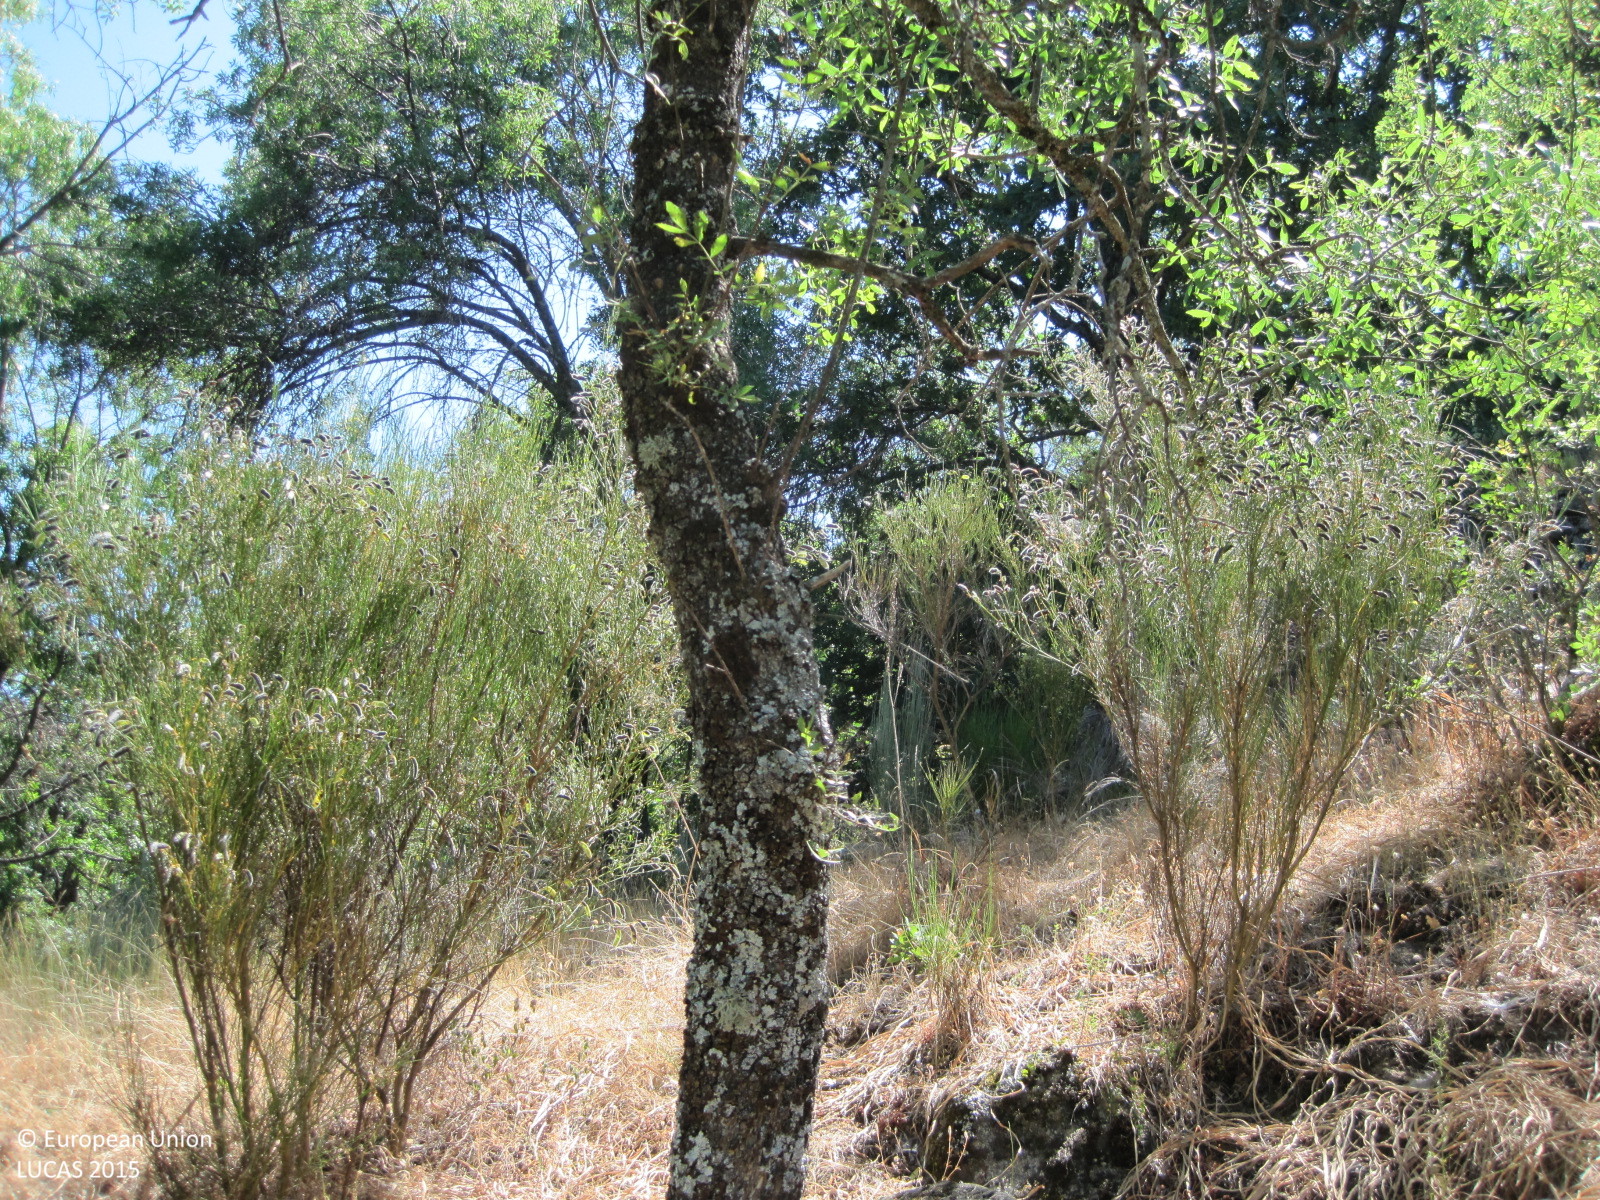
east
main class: Woodland
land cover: Broadleaved woodland
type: broadleaved evergreen forest
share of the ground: > 75 %
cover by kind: broadleaved forest trees 90 %, shrubs 5 %, herbaceous plants 5 %
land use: Semi-natural and natural areas not in use
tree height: > 5 m
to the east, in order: Broadleaved woodland; Rivers and streams; Broadleaved woodland; Rivers and streams; Broadleaved woodland; Rivers and streams; Broadleaved woodland; Dry stone walls; Tracks; Rock outcrops; Broadleaved woodland; Dry stone walls; Rock outcrops
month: July
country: ES
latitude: 40.3663
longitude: -4.8092
